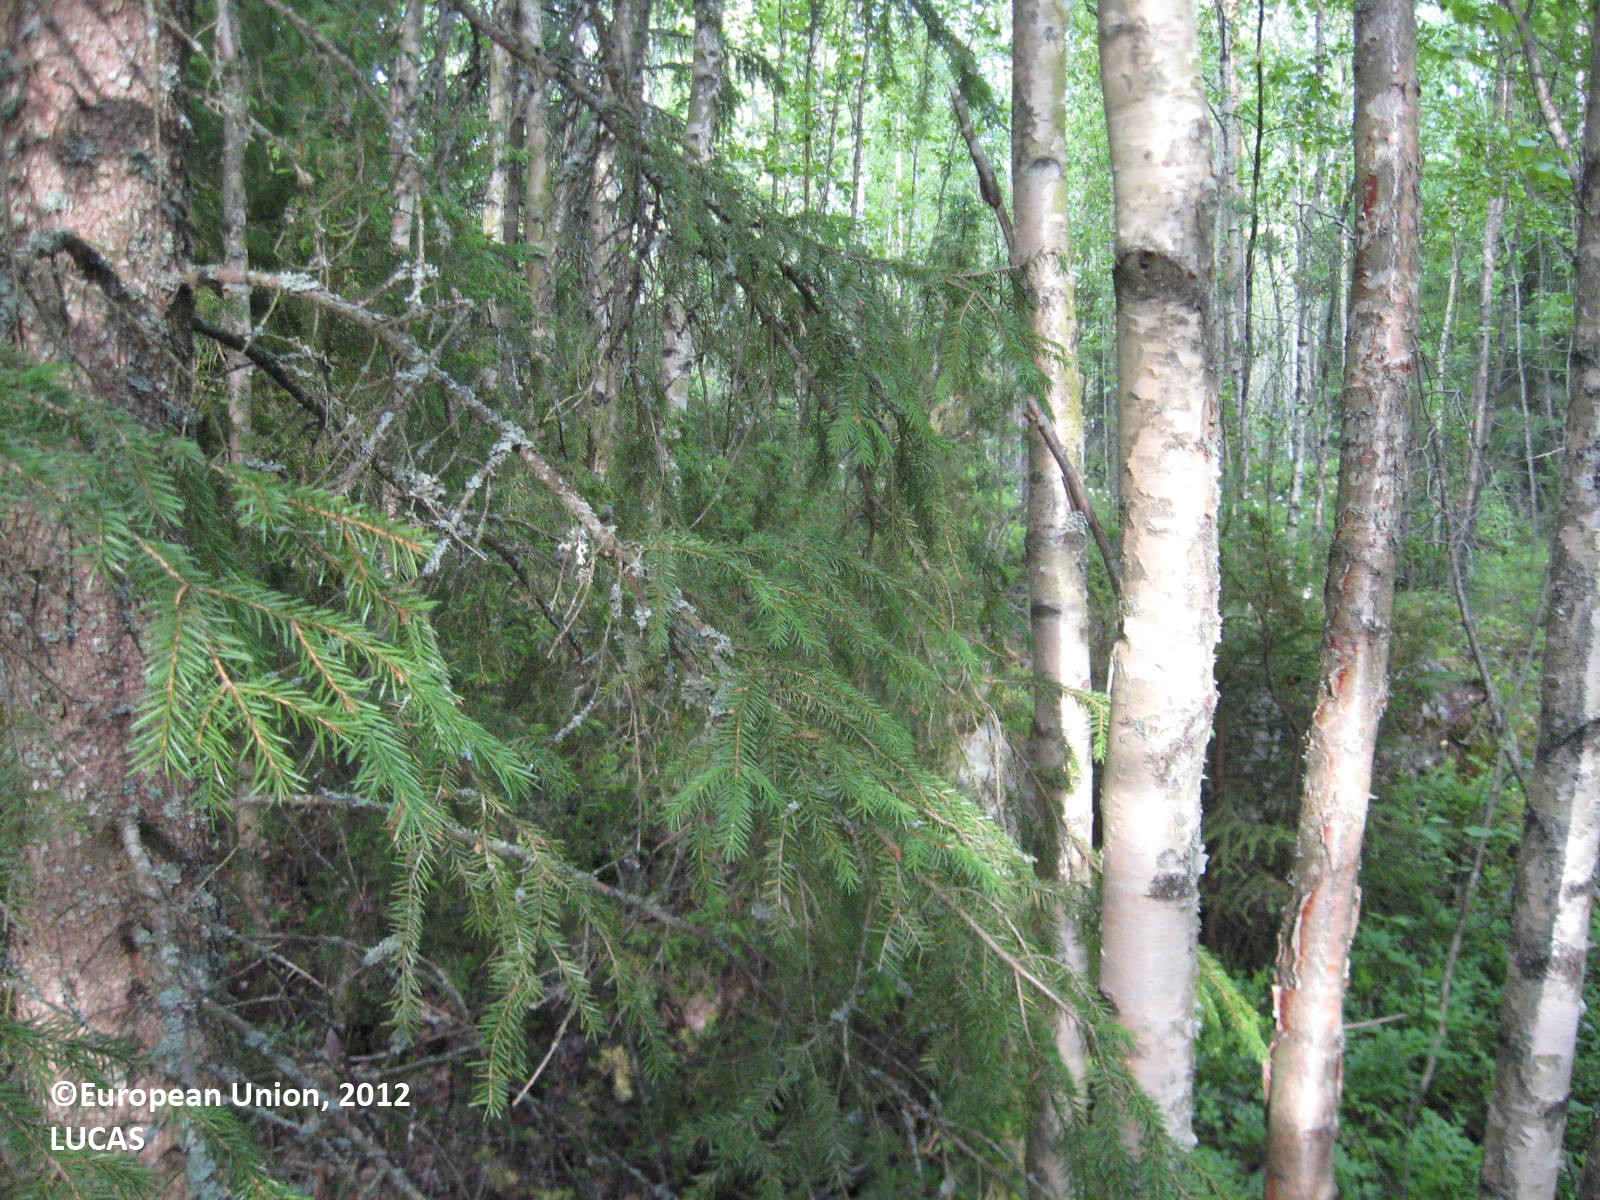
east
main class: Woodland
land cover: Spruce dominated mixed woodland
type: boreal forest
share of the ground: > 75 %
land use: Forestry
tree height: > 5 m
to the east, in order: Spruce dominated mixed woodland; Other mixed woodland
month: June
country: FI
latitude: 62.9759
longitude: 22.6198
